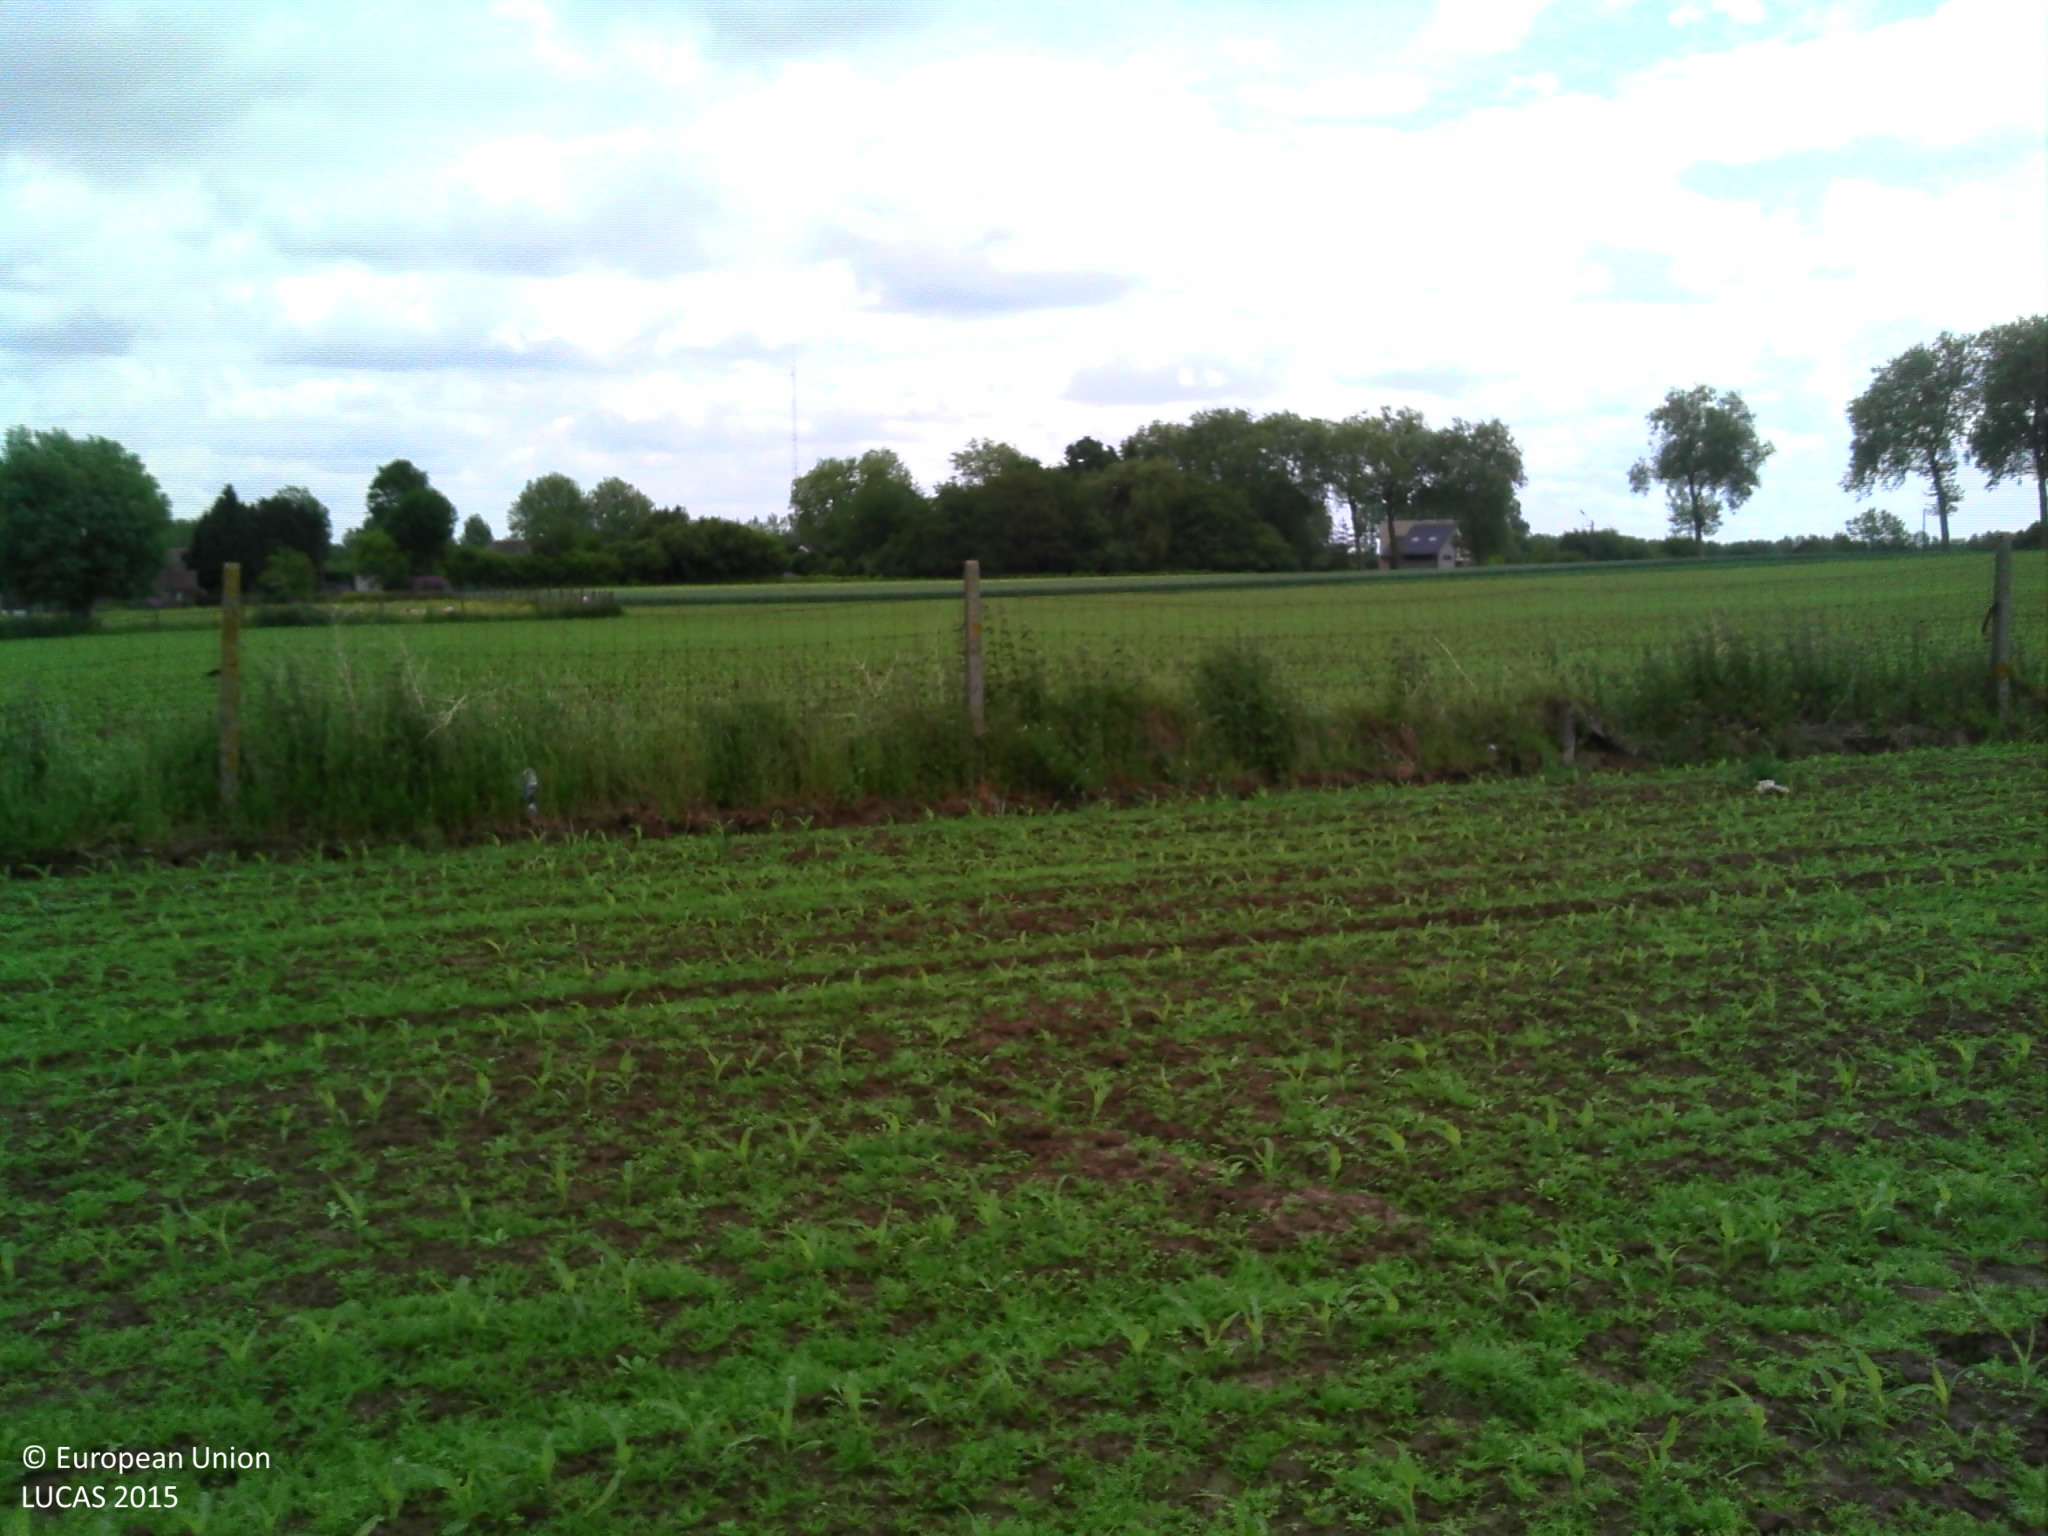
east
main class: Cropland
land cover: Maize
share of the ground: 10 - 25 %
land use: Agriculture (excluding fallow land and kitchen gardens)
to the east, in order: Maize; Fences; Maize; Sugar beet; Common wheat; Barley; Artificial constructions in urban areas
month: June
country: BE
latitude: 50.8131
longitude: 3.8767
